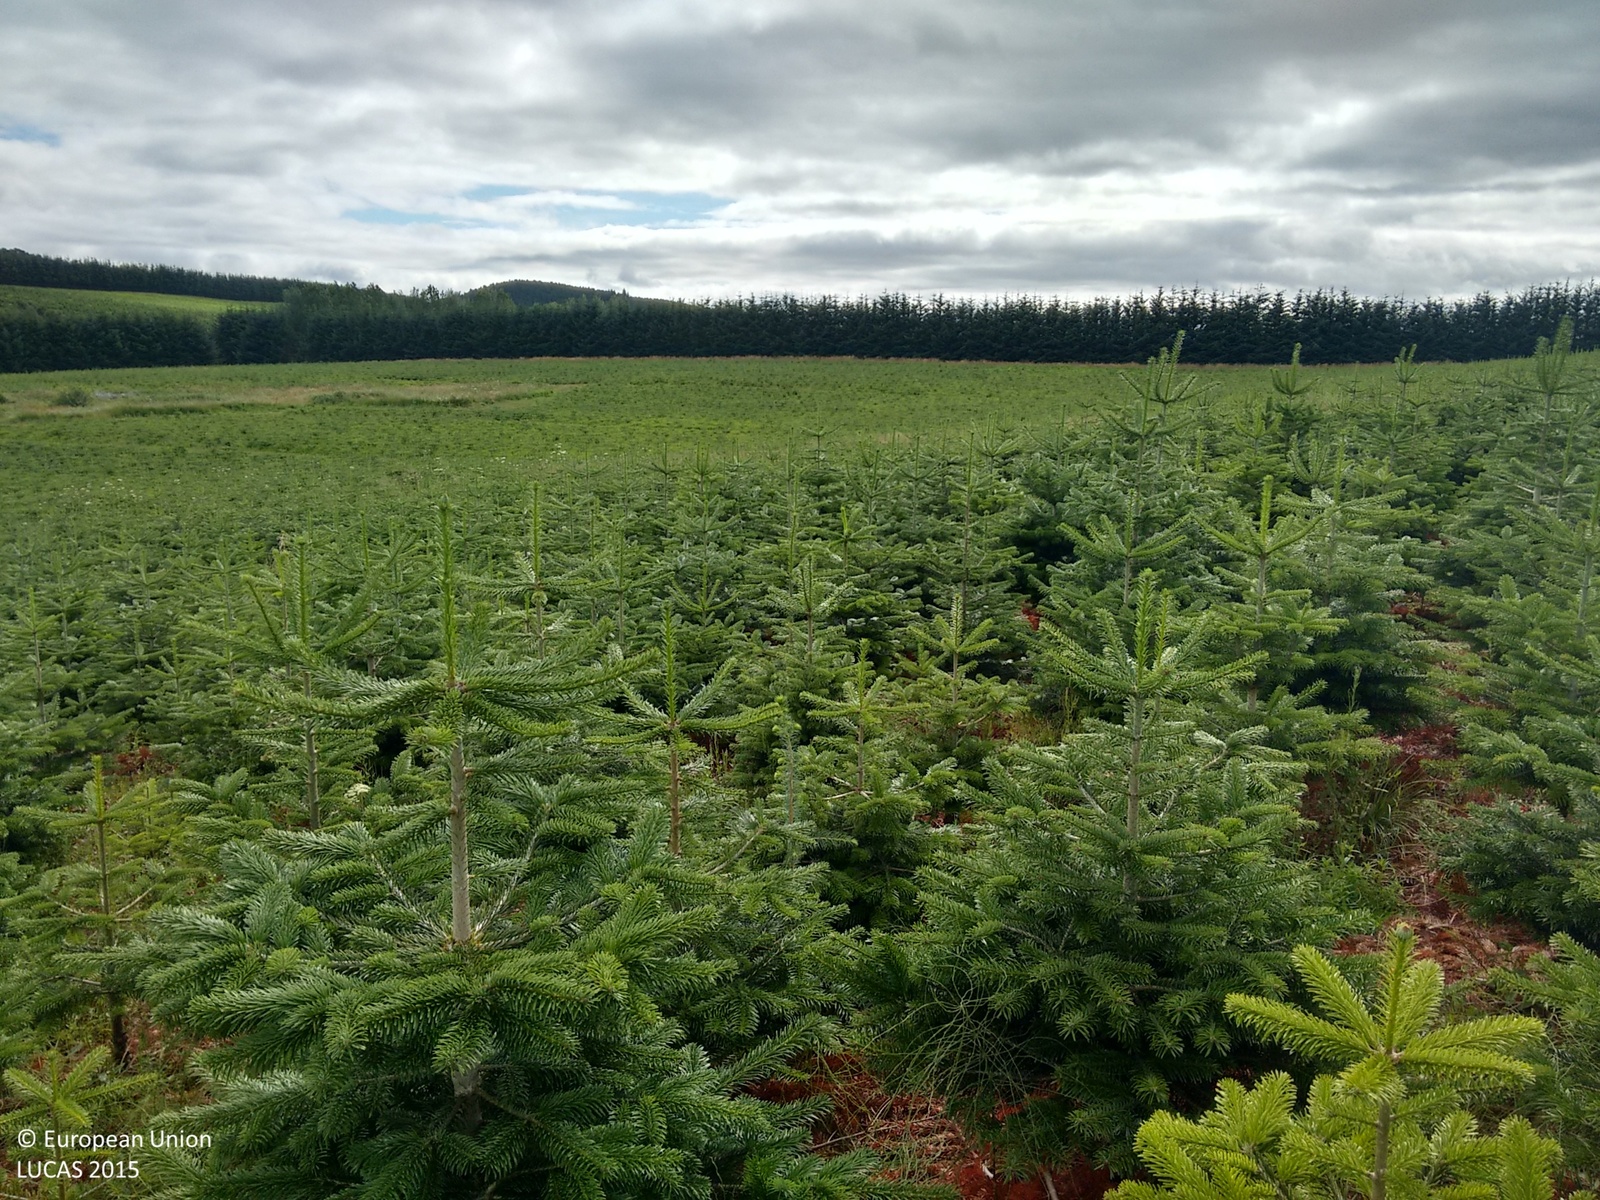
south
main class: Woodland
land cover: Spruce dominated coniferous woodland
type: exotic forest
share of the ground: > 75 %
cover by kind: coniferous forest trees 70 %, herbaceous plants 15 %, unconsolidated bare surface 15 %
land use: Forestry
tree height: < 5 m
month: August
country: GB
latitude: 57.5299
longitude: -4.2306
